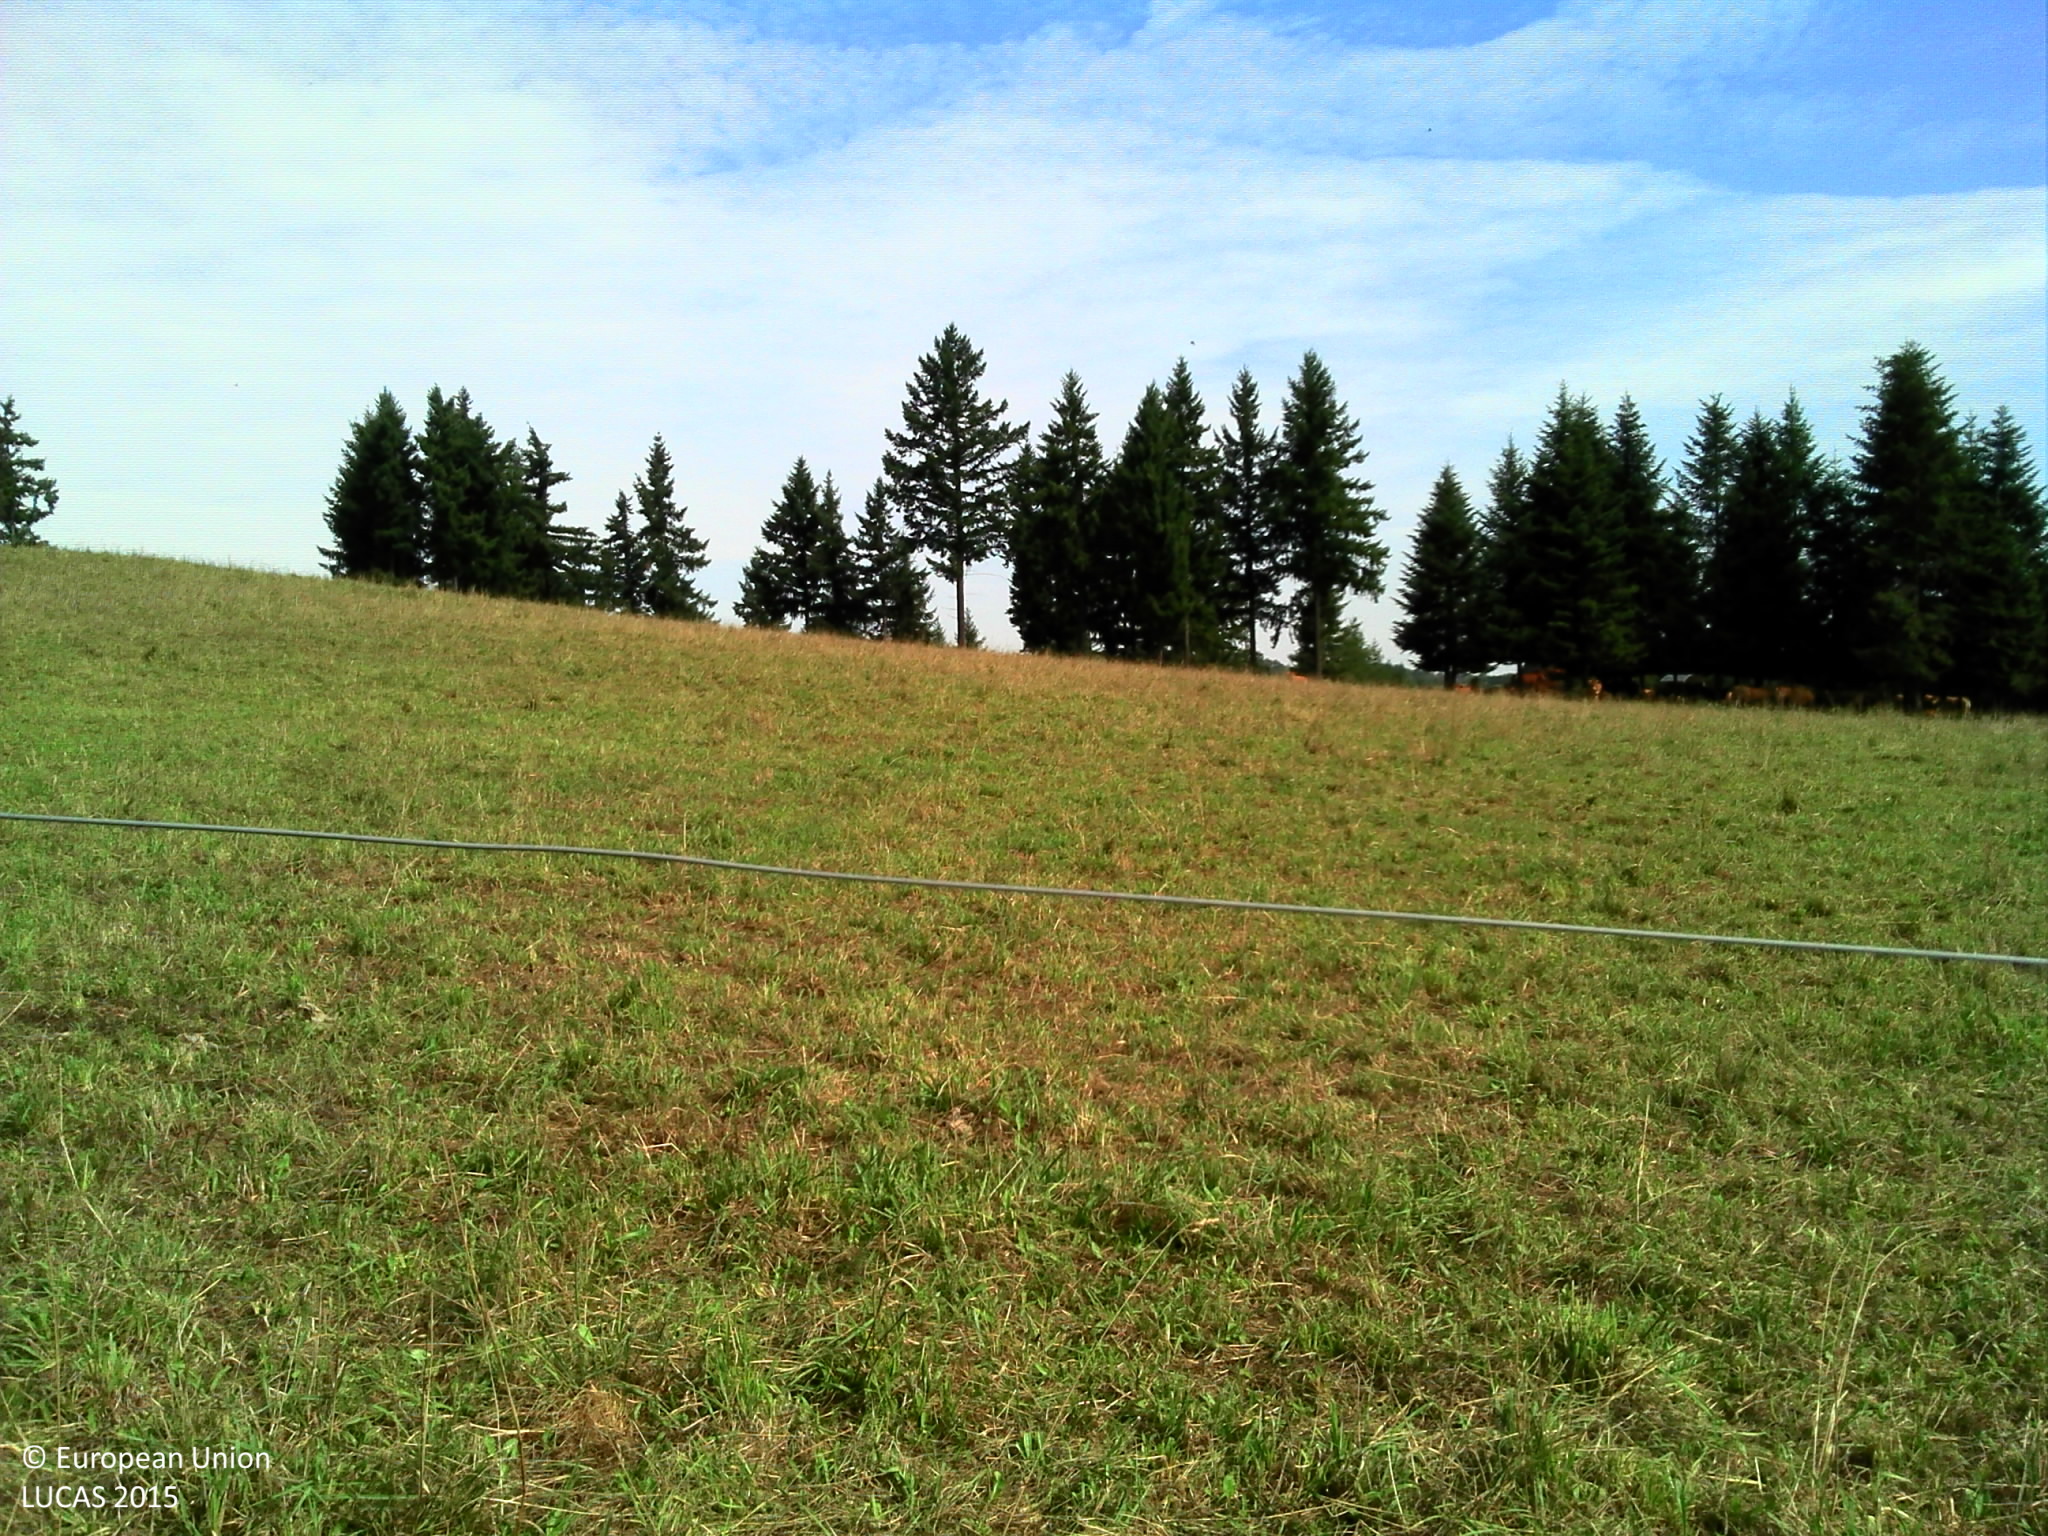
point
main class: Grassland
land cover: Grassland without tree/shrub cover
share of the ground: > 75 %
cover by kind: herbaceous plants 95 %
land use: Agriculture (excluding fallow land and kitchen gardens)
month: August
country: FR
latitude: 45.6145
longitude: 1.2846
